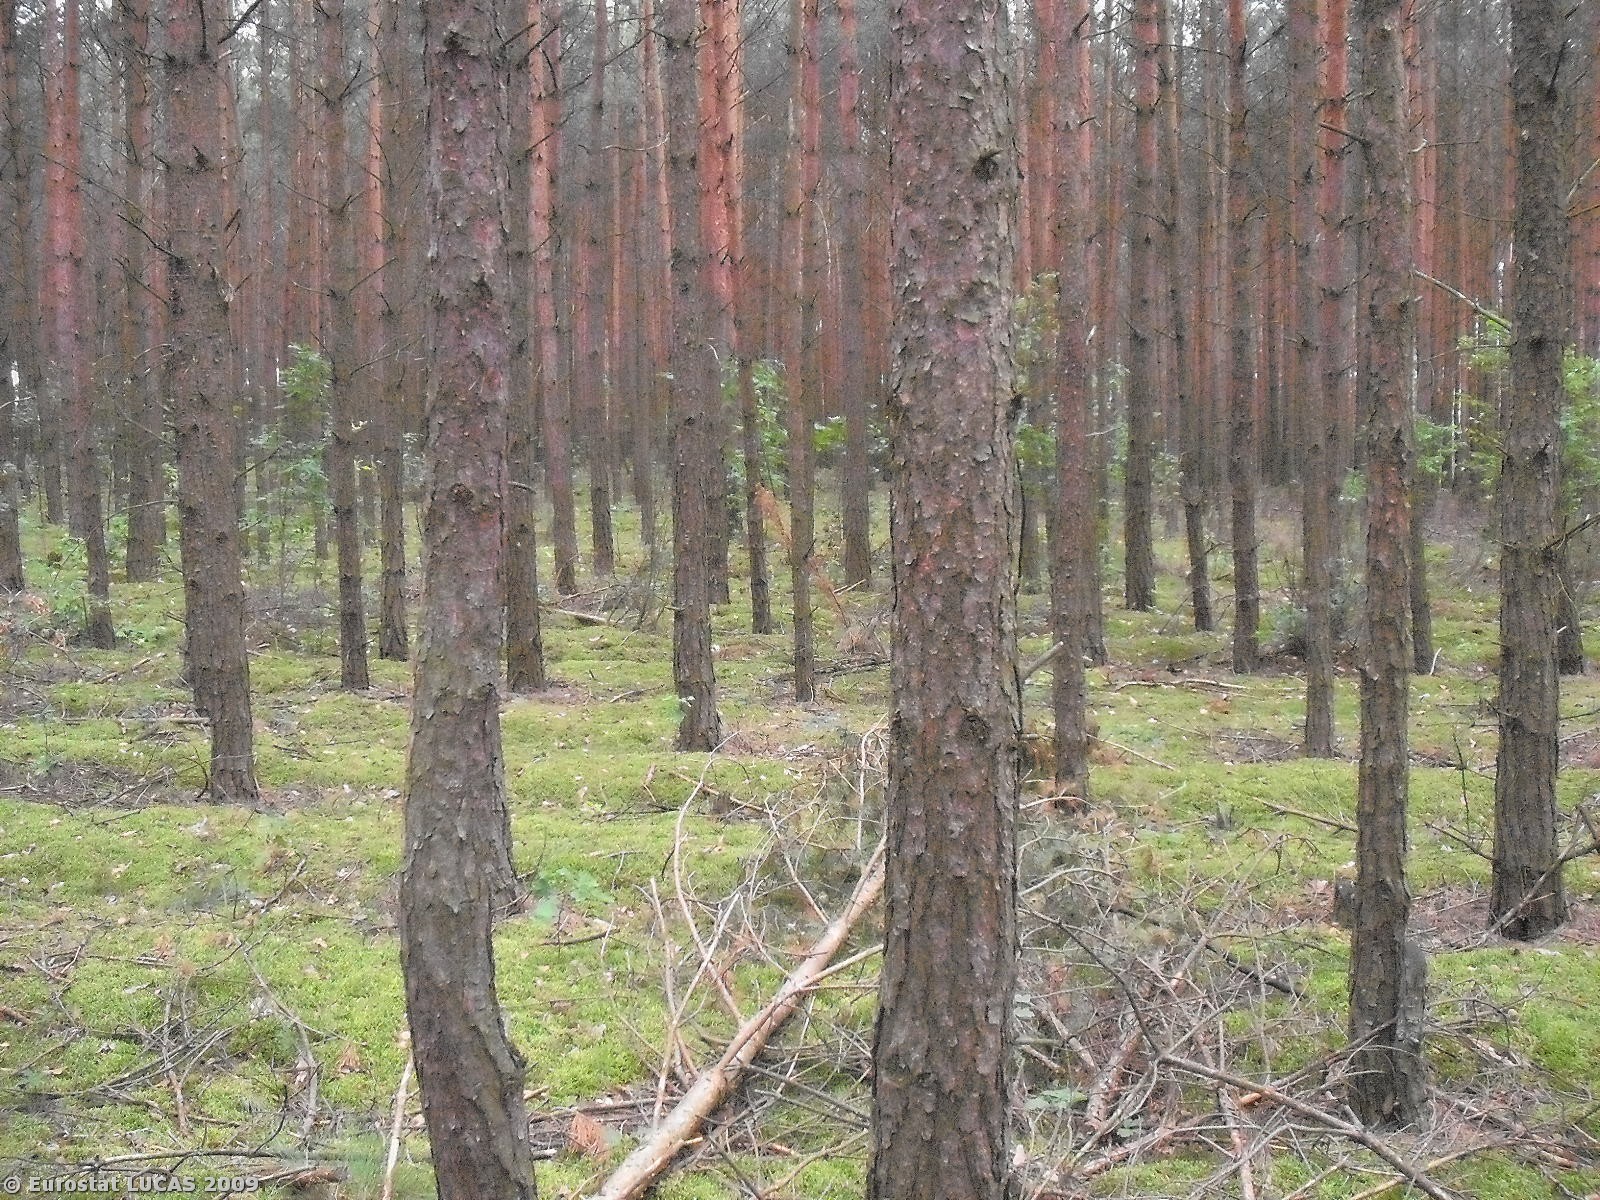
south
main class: Woodland
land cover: Coniferous woodland
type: hemiboreal forest and nemoral coniferous forest and mixed broadleaved-coniferous forest
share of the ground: > 75 %
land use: Forestry
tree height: > 5 m
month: June
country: PL
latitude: 51.4111
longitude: 20.6071
